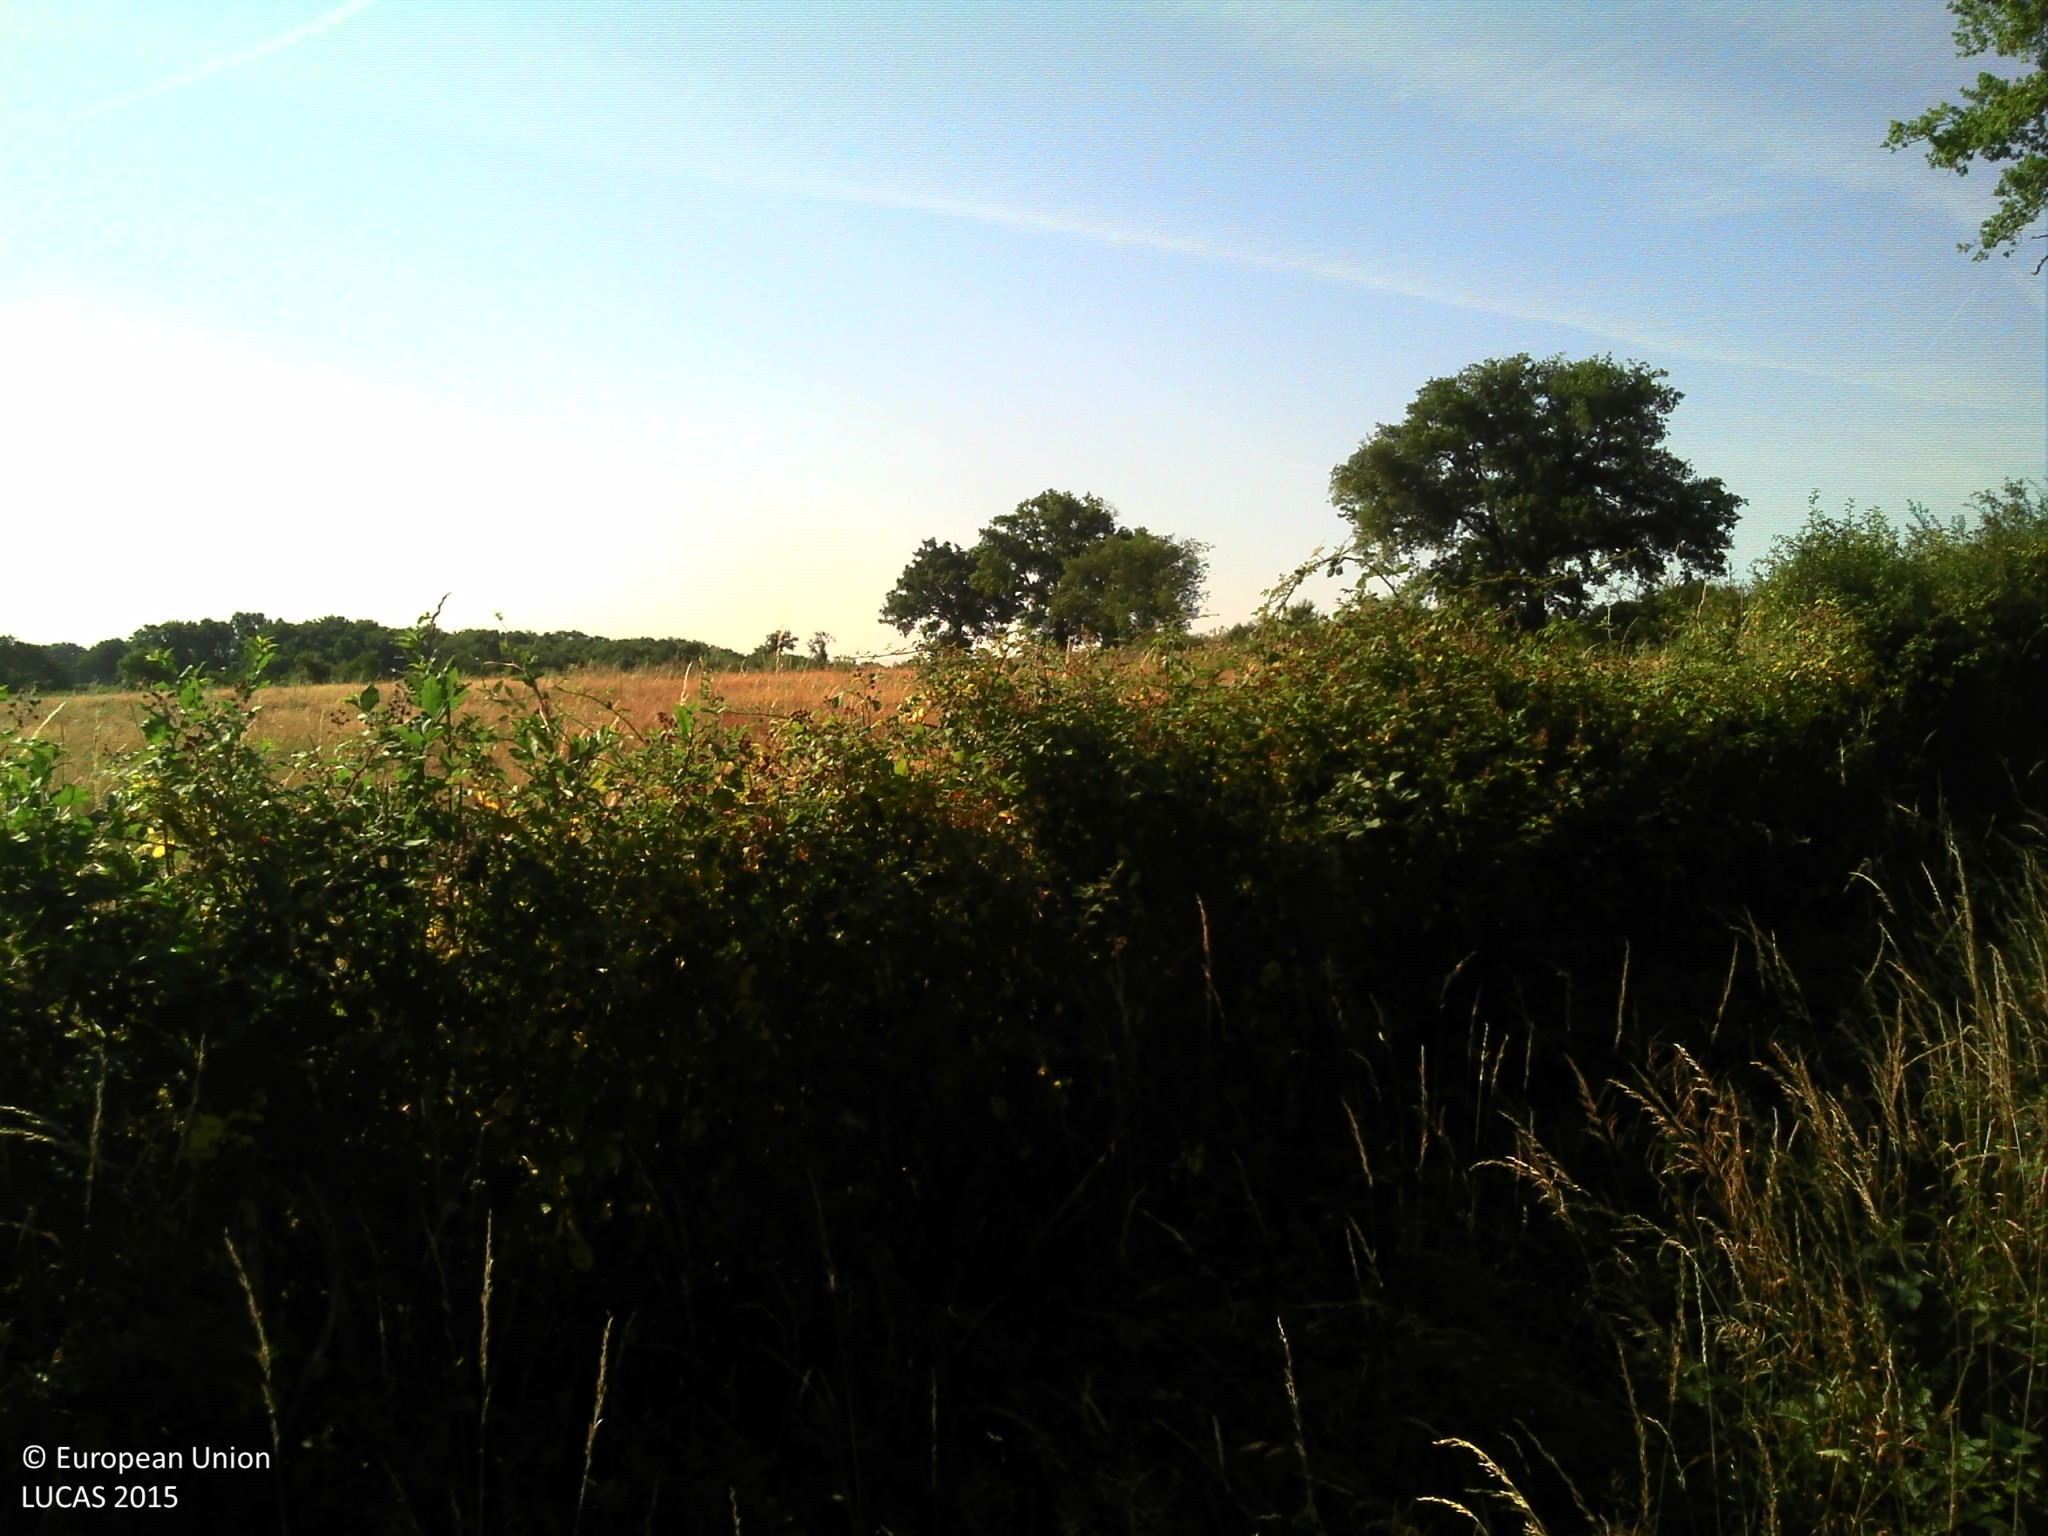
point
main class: Grassland
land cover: Spontaneously vegetated surfaces
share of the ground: > 75 %
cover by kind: herbaceous plants 100 %
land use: Fallow land
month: July
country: FR
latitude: 46.3234
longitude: 0.8814
